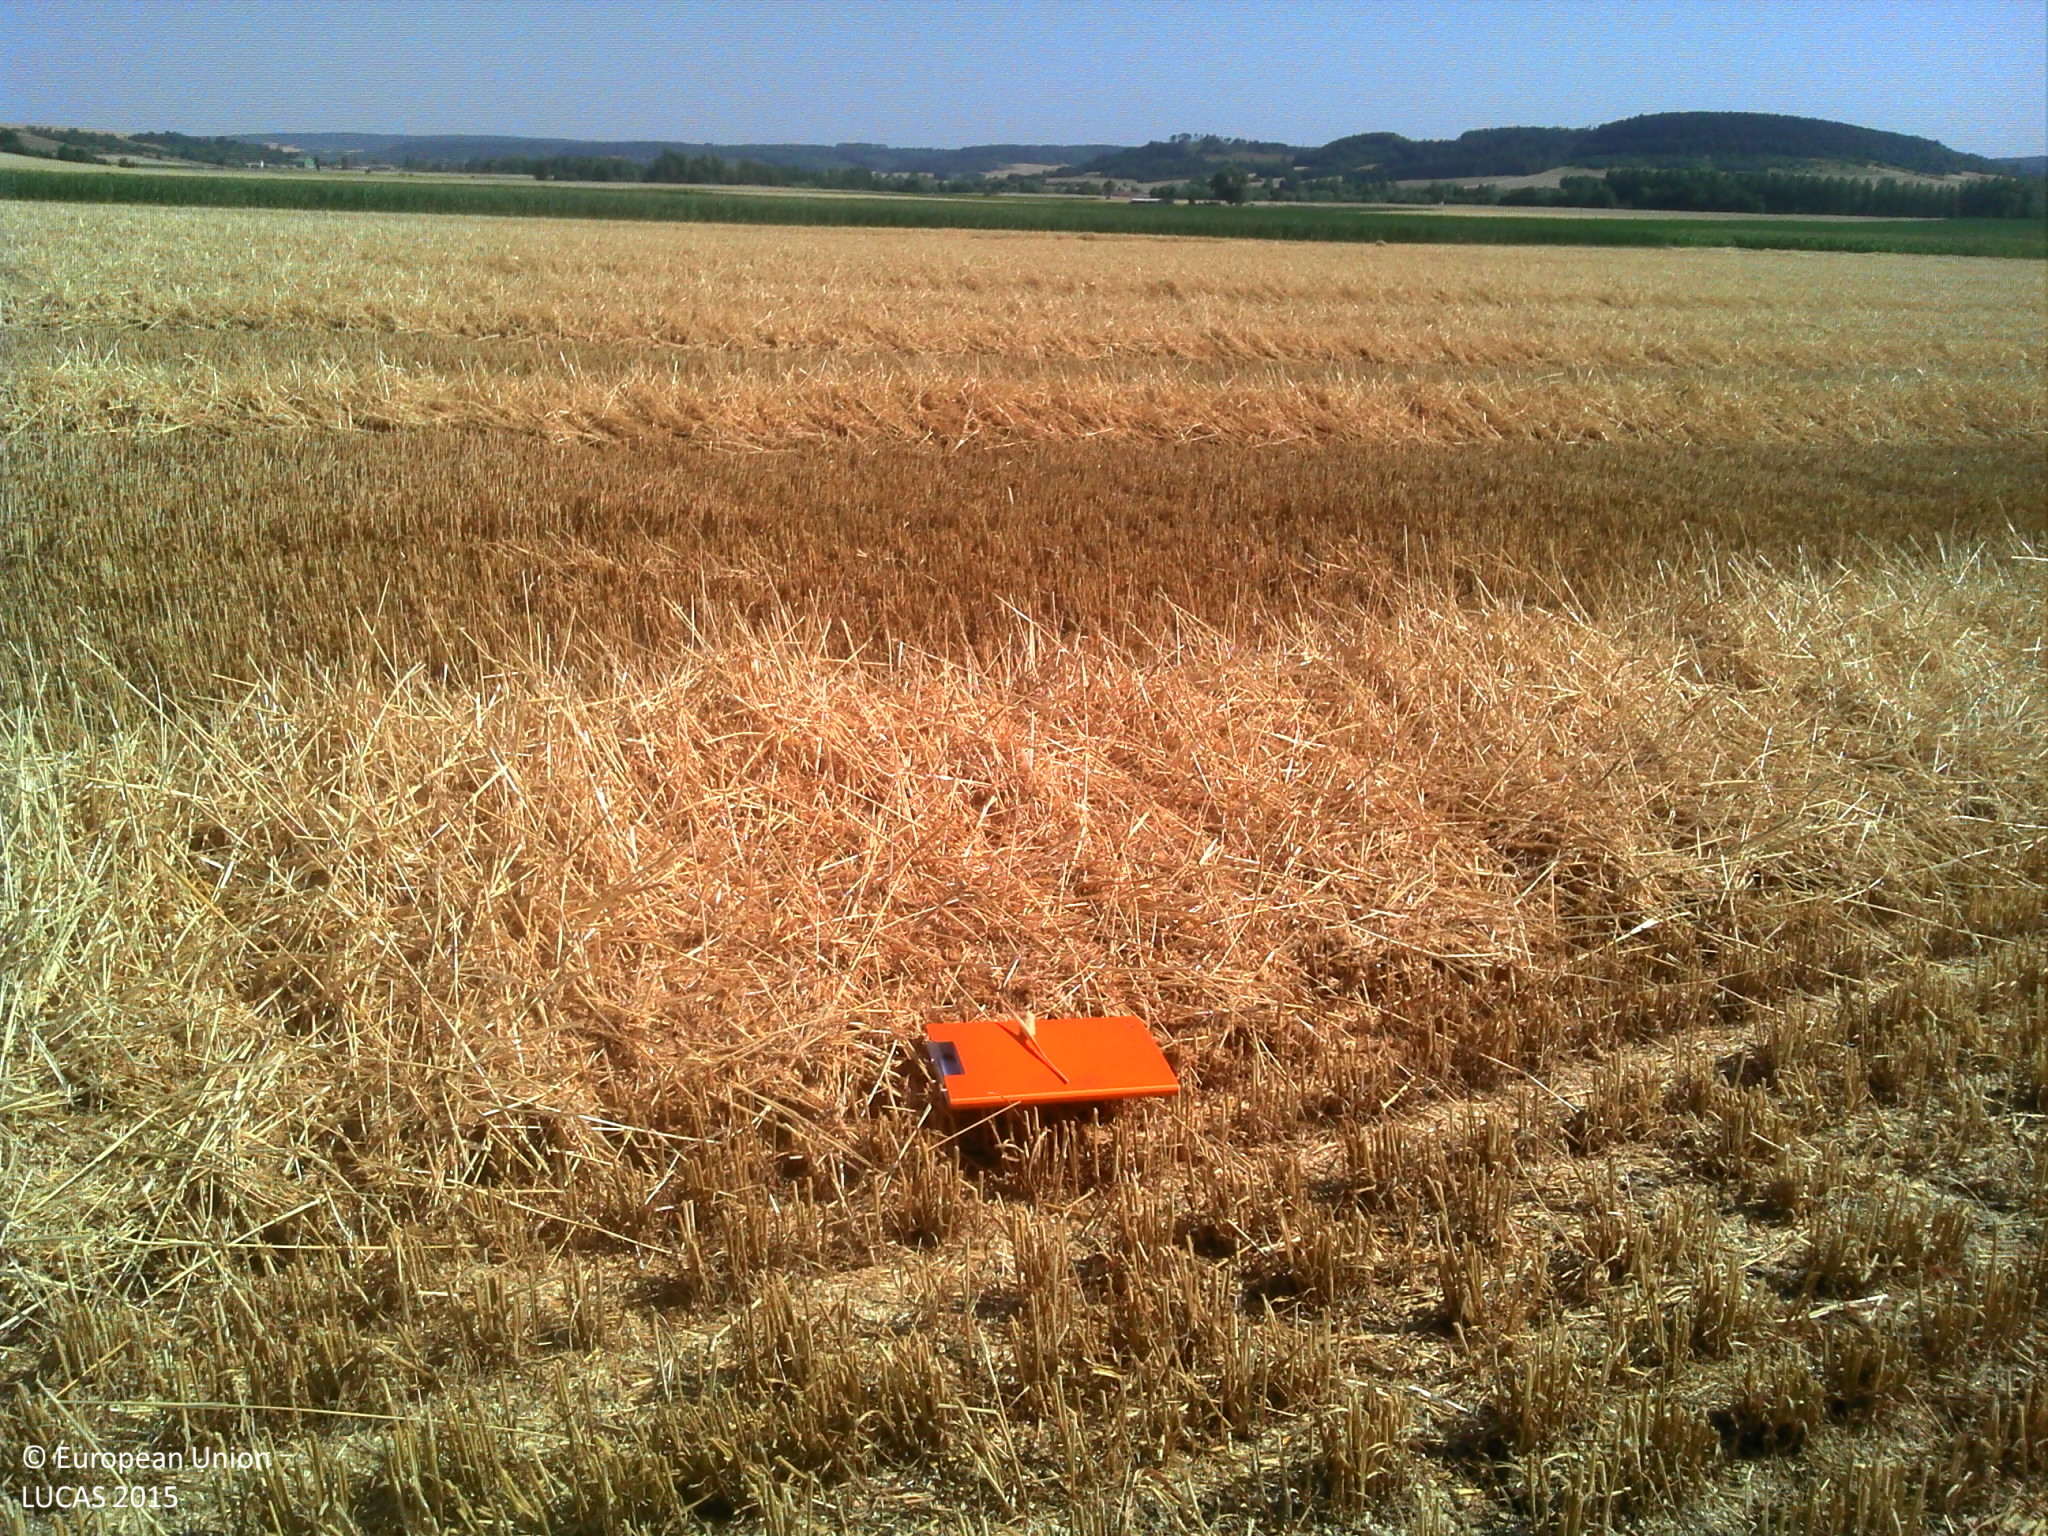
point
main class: Cropland
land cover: Common wheat
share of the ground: 10 - 25 %
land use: Agriculture (excluding fallow land and kitchen gardens)
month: July
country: FR
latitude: 48.0509
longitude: 4.8874
